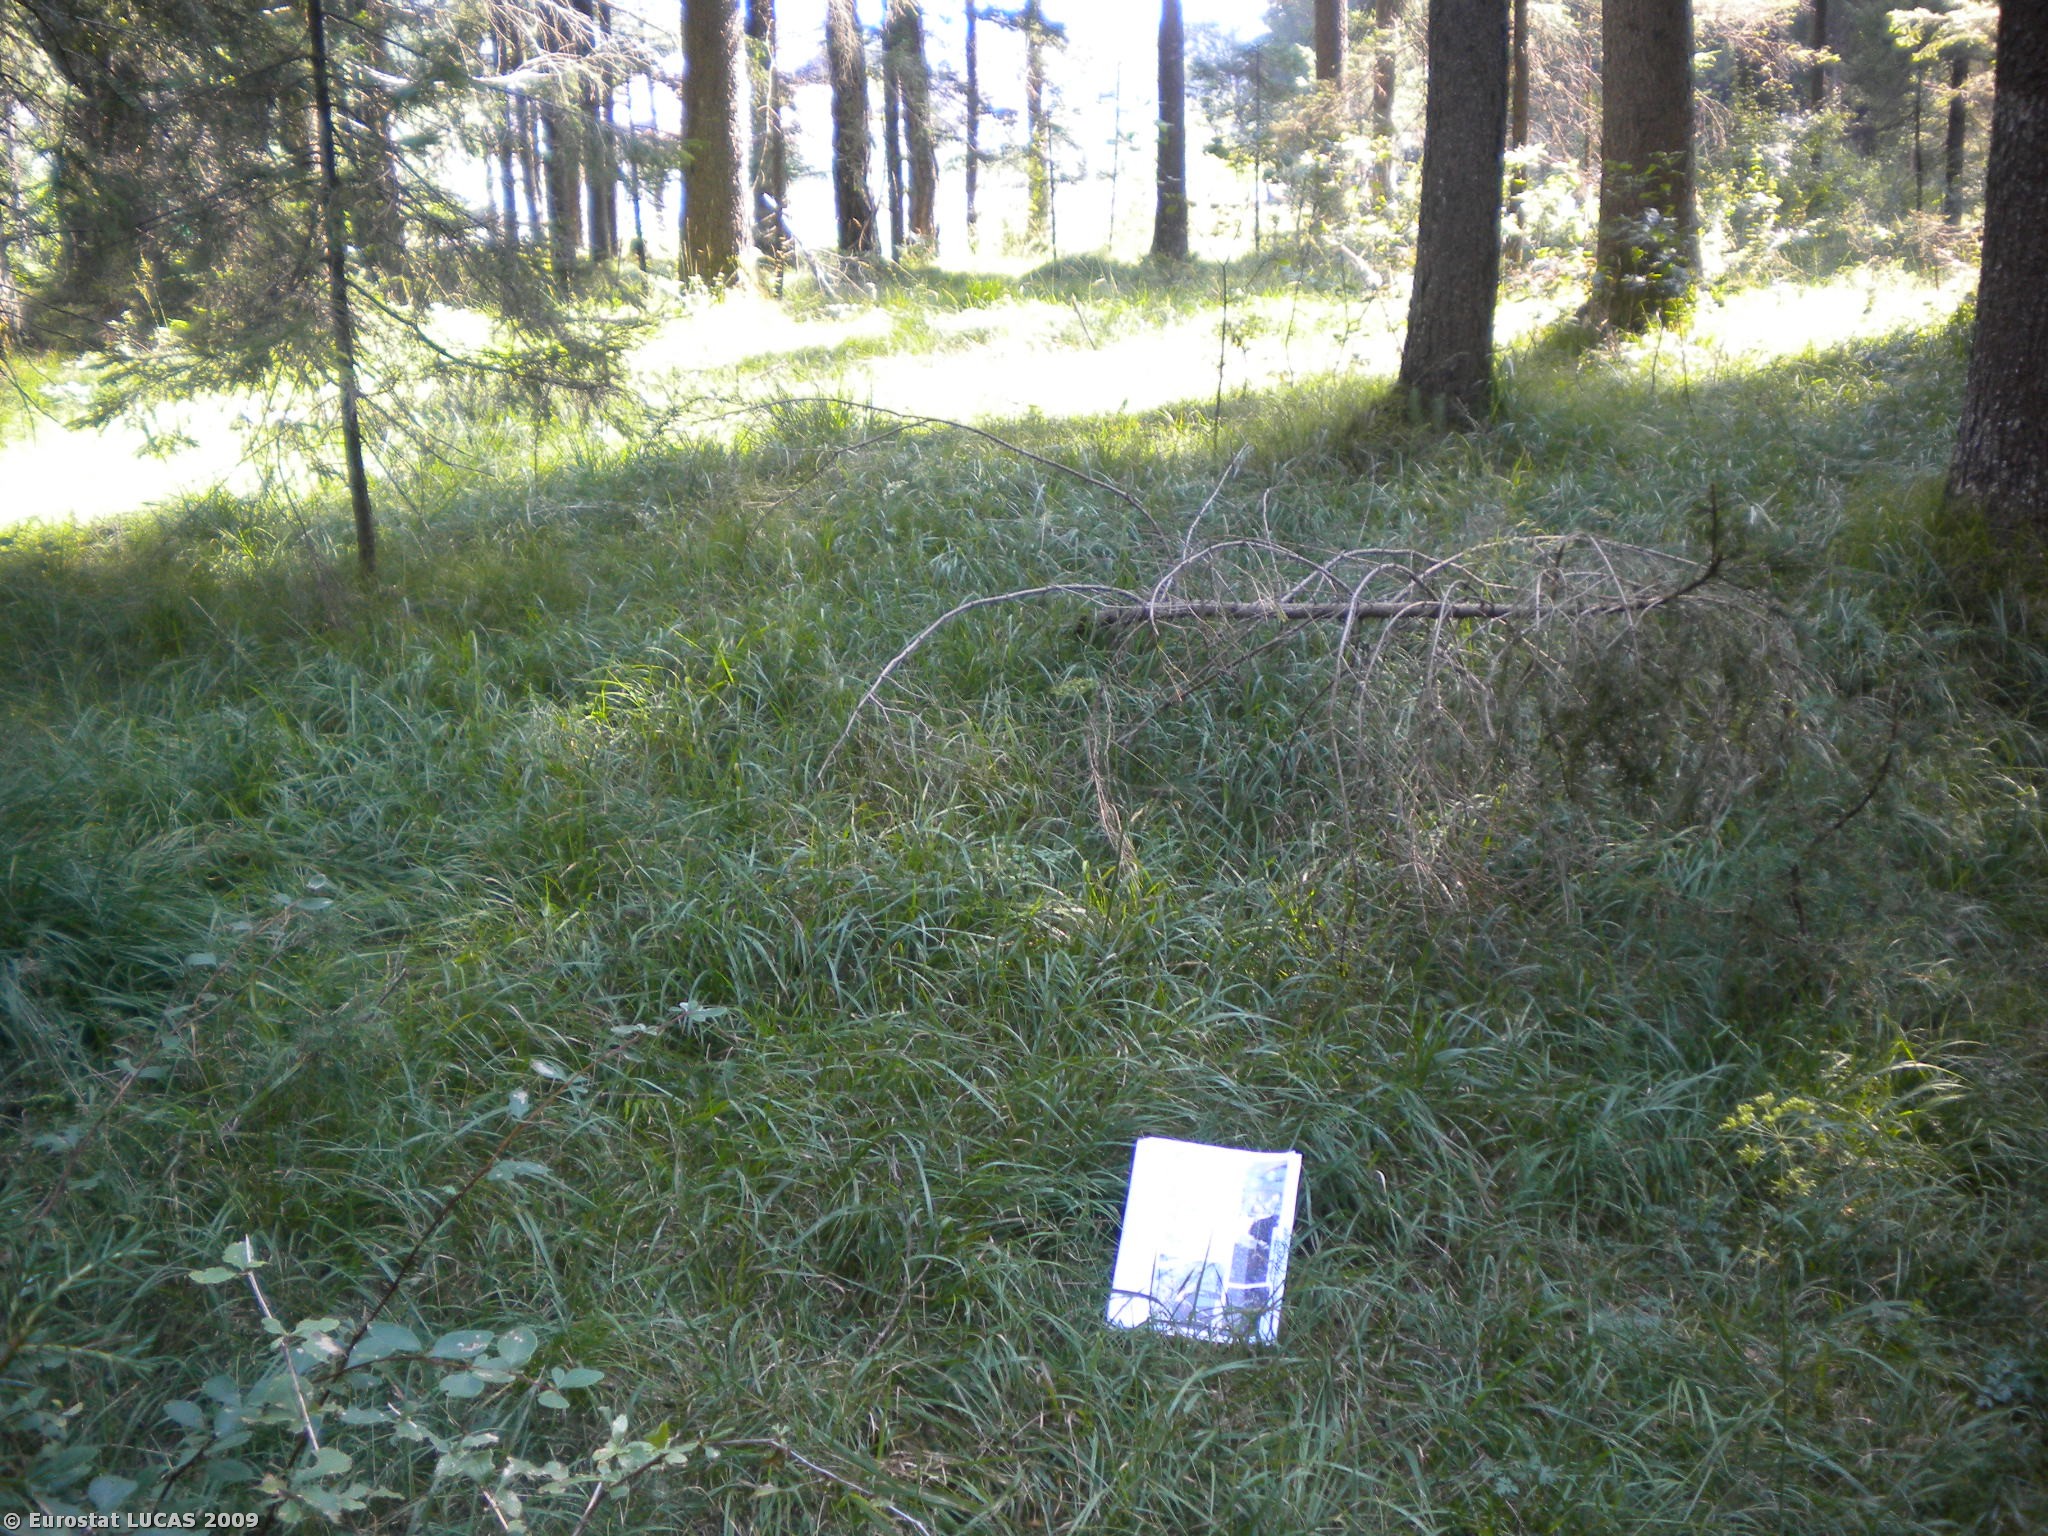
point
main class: Woodland
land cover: Coniferous woodland
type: alpine coniferous forest
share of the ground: > 75 %
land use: Forestry
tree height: > 5 m
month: August
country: AT
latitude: 46.7381
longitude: 13.1252
